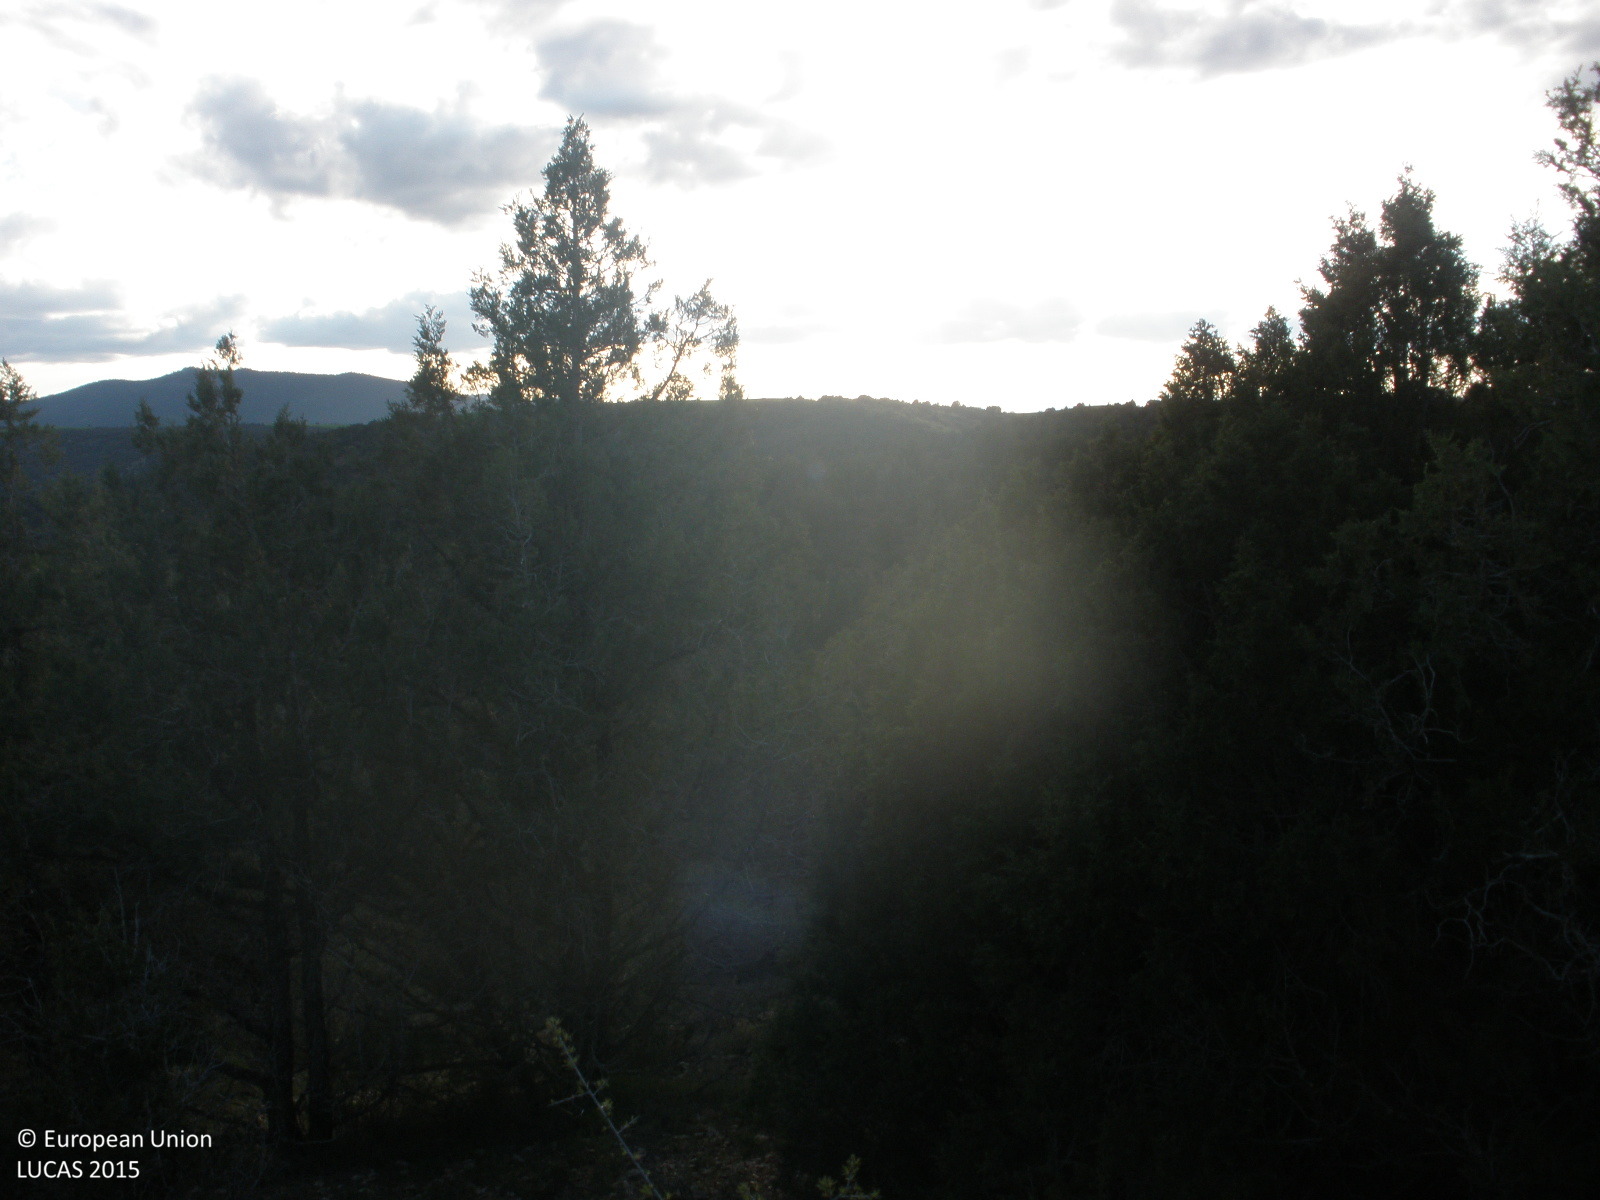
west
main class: Woodland
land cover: Other coniferous woodland
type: coniferous forest of the mediterranean region
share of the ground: 50 - 75 %
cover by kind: coniferous forest trees 60 %, consolidated bare surface 30 %, shrubs 10 %
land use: Semi-natural and natural areas not in use
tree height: < 5 m
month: April
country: ES
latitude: 40.3832
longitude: -1.2614
